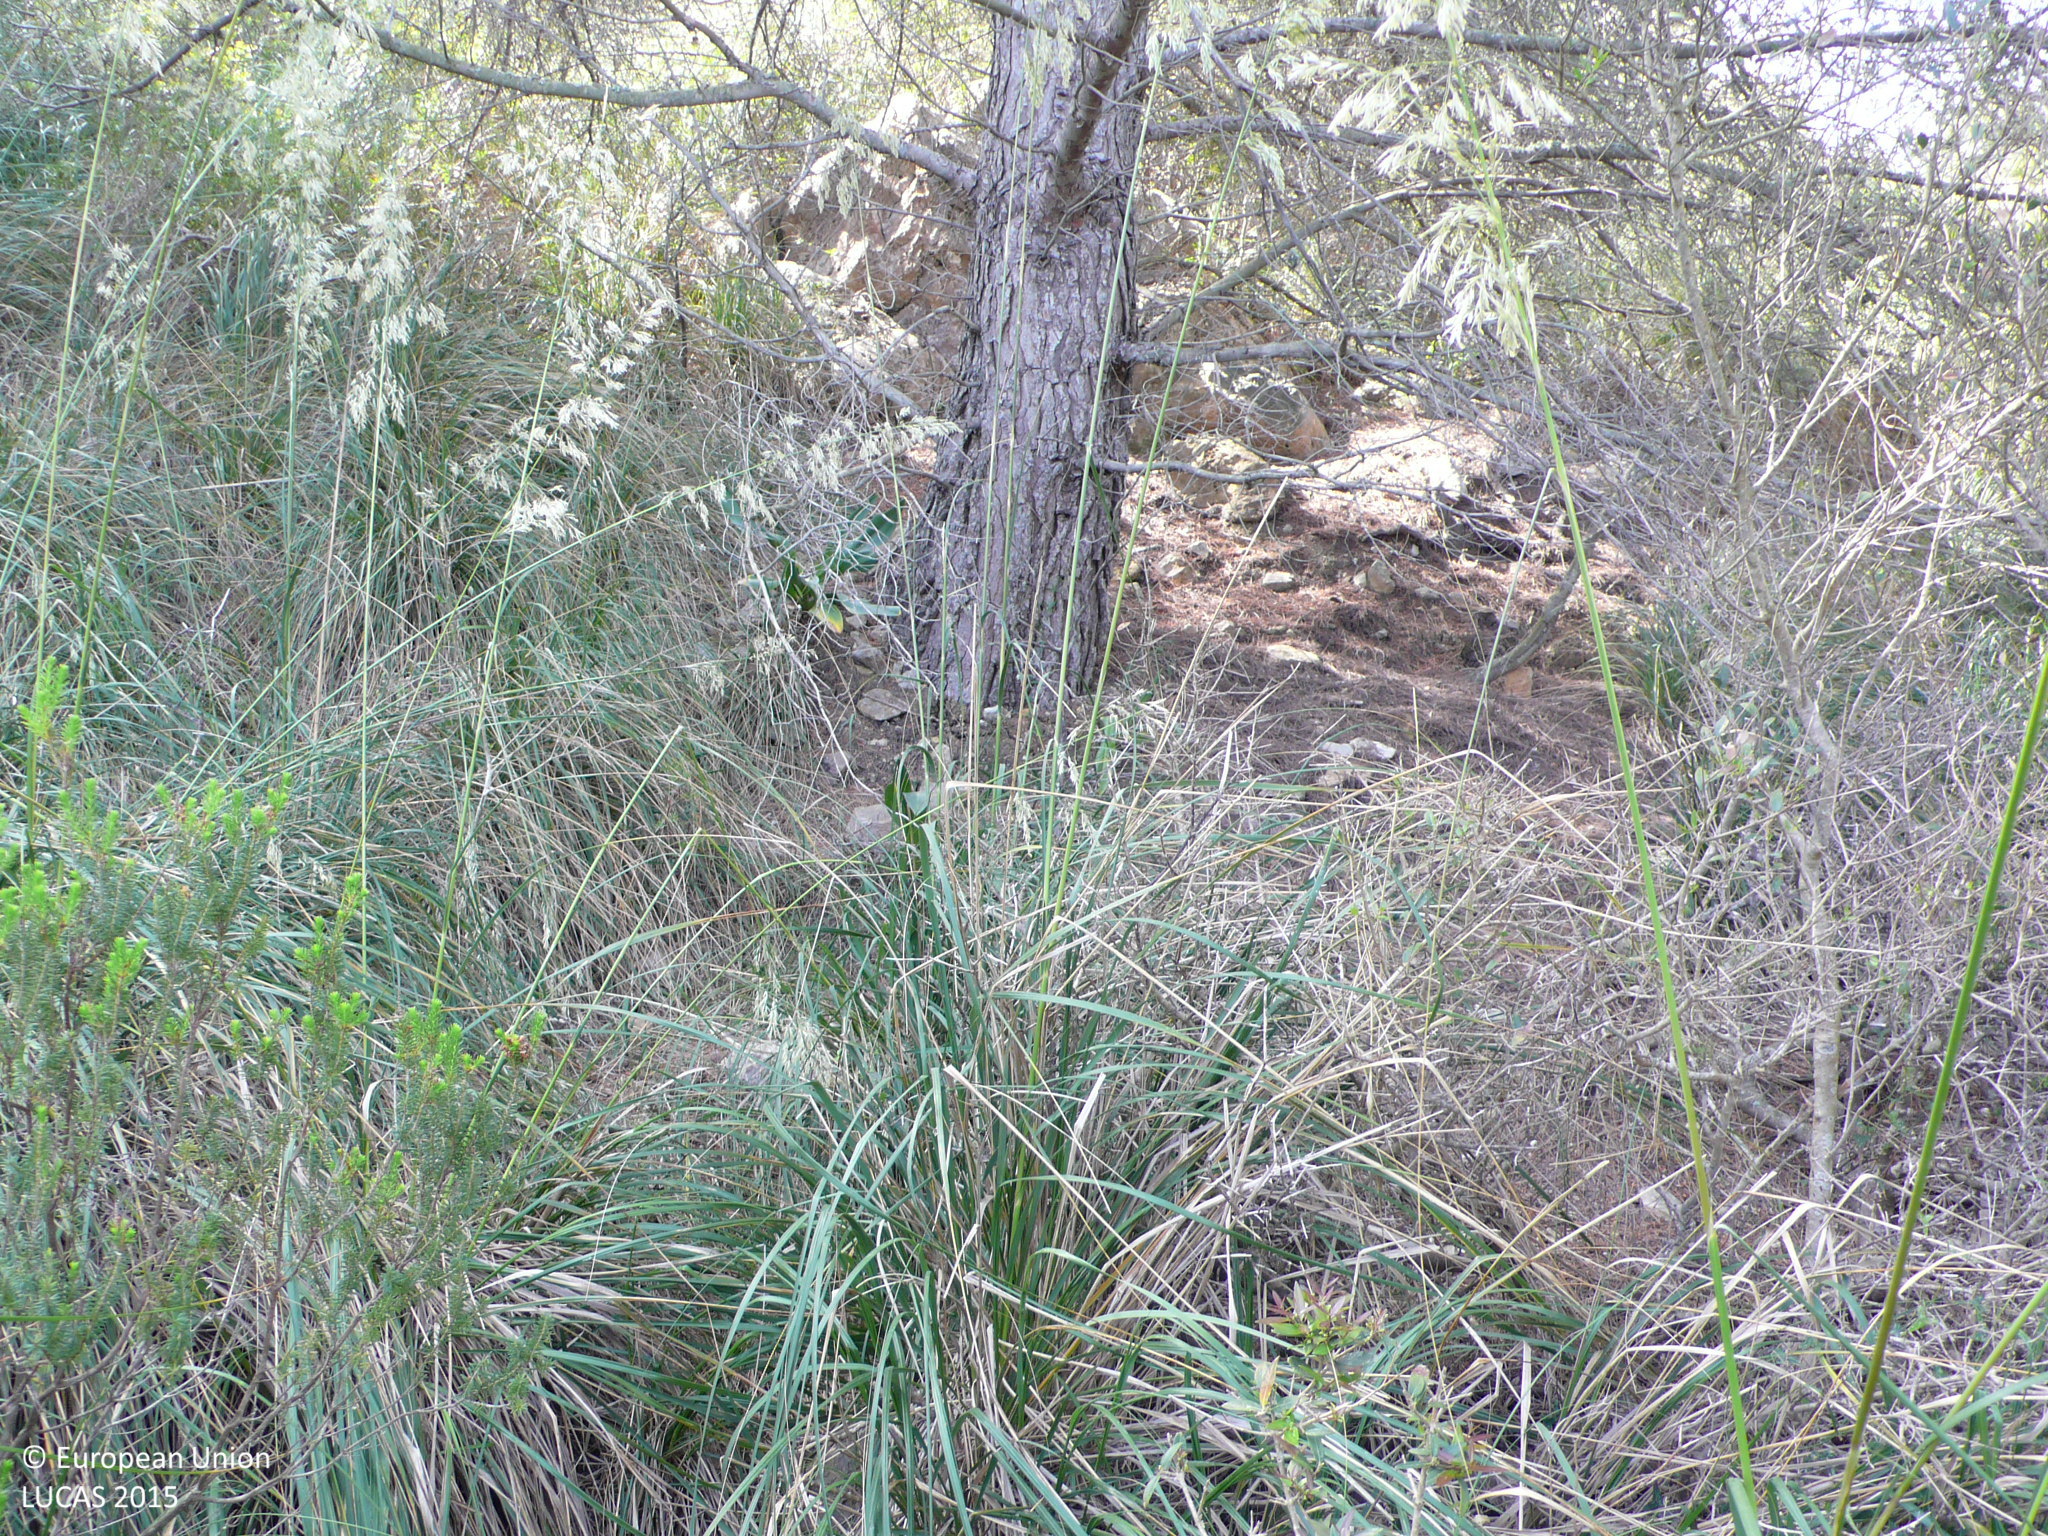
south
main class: Woodland
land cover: Pine dominated coniferous woodland
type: coniferous forest of the mediterranean region
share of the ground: > 75 %
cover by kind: coniferous forest trees 75 %, herbaceous plants 15 %, shrubs 10 %
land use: Semi-natural and natural areas not in use
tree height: > 5 m
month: May
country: ES
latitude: 40.0204
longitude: 4.1555
